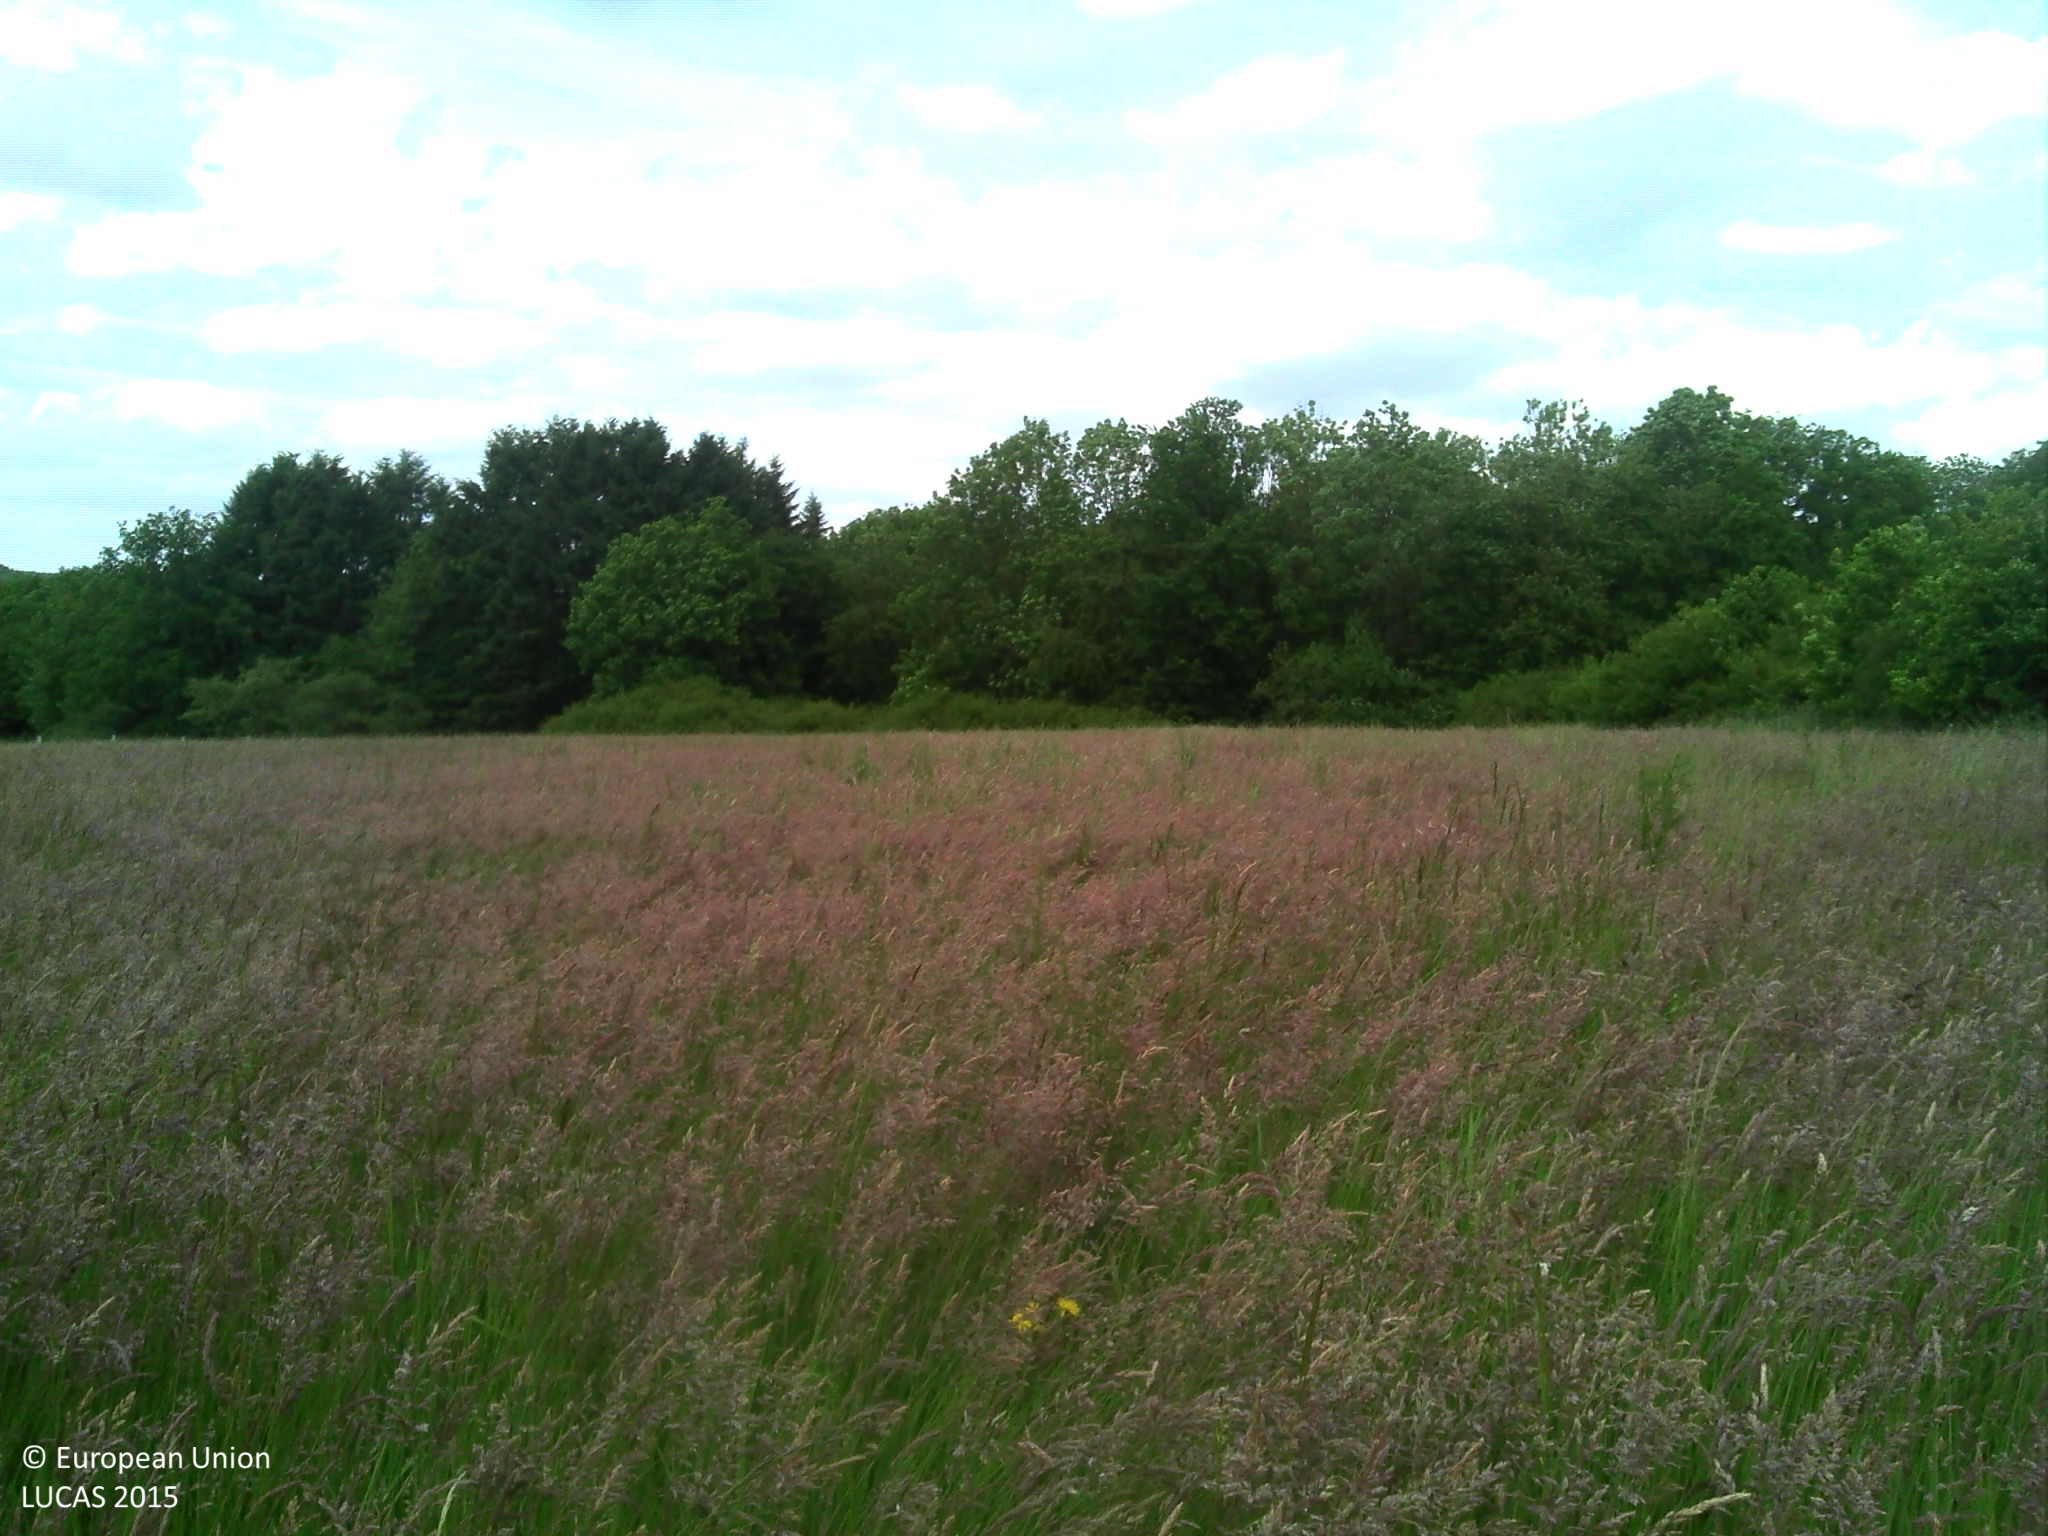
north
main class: Grassland
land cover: Grassland without tree/shrub cover
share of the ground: > 75 %
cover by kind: herbaceous plants 100 %
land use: Agriculture (excluding fallow land and kitchen gardens)
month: May
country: BE
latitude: 50.1751
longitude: 4.8300
